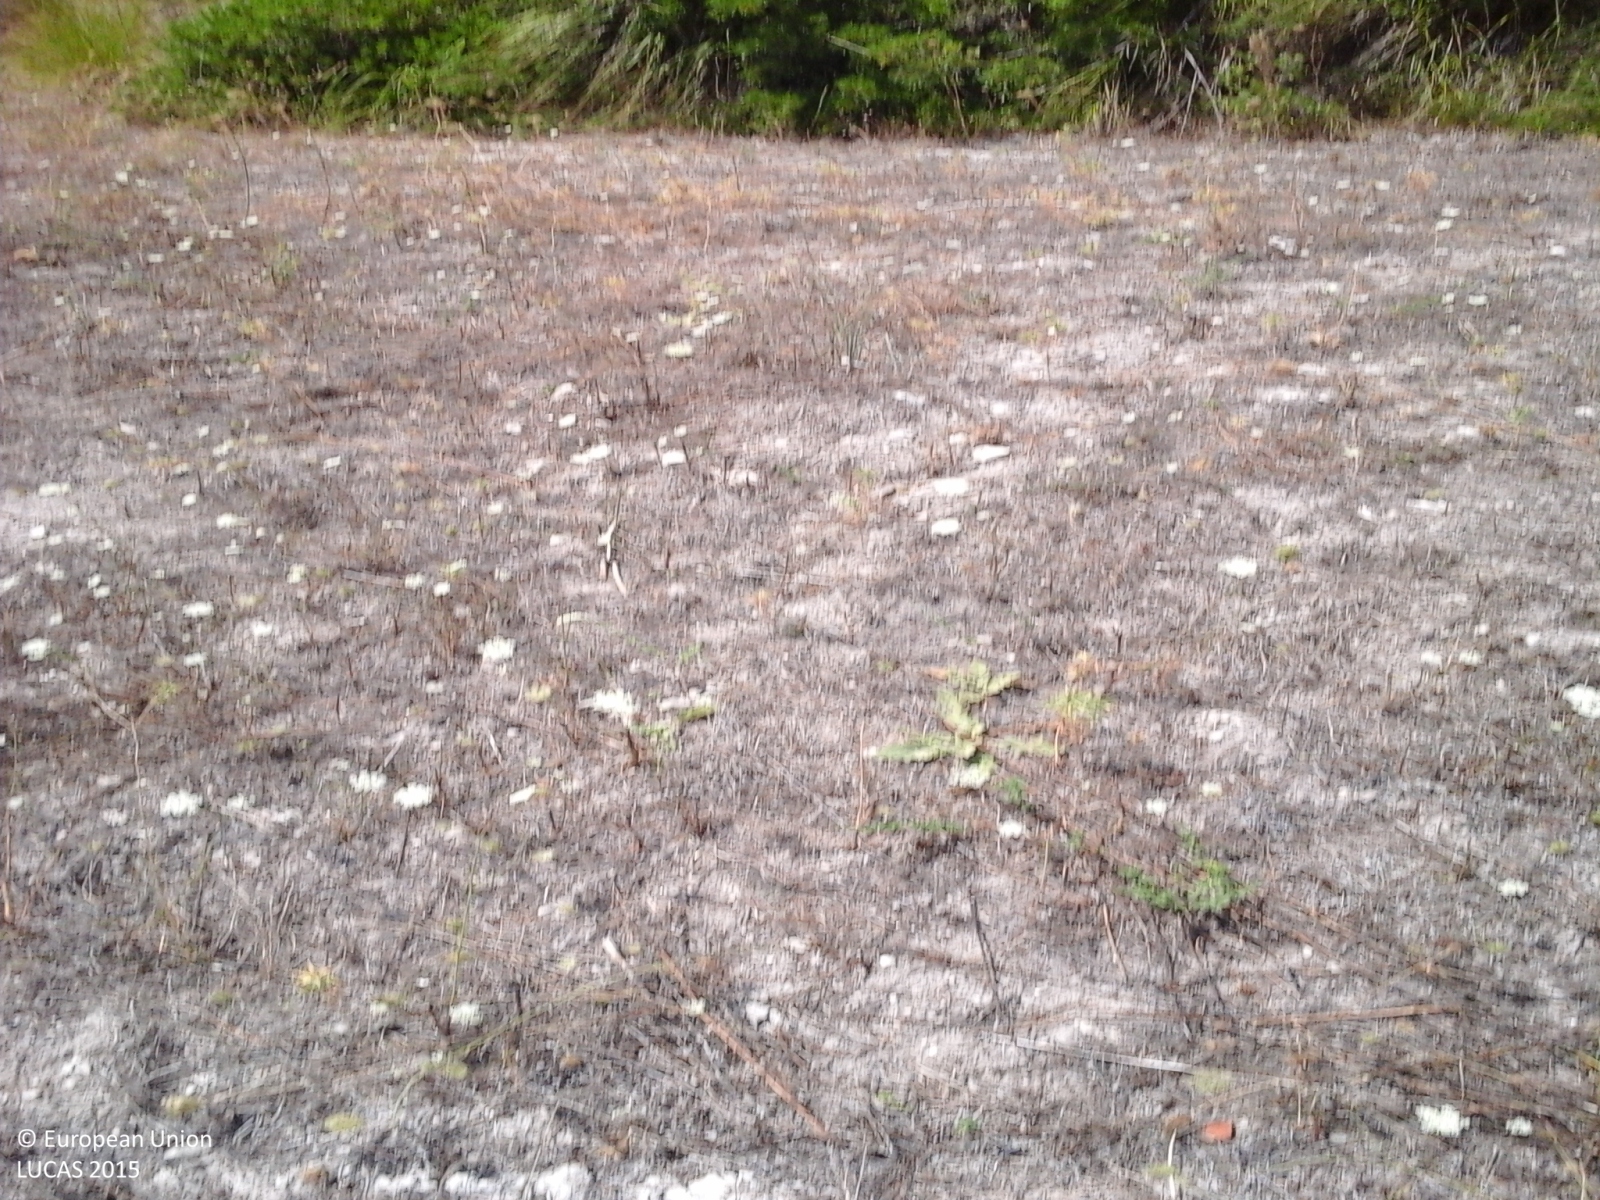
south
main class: Shrubland
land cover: Shrubland with sparse tree cover
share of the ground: > 75 %
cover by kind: herbaceous plants 55 %, shrubs 40 %, coniferous forest trees 5 %
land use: Agriculture (excluding fallow land and kitchen gardens)
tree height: < 5 m
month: August
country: IT
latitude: 36.9498
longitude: 14.8691
